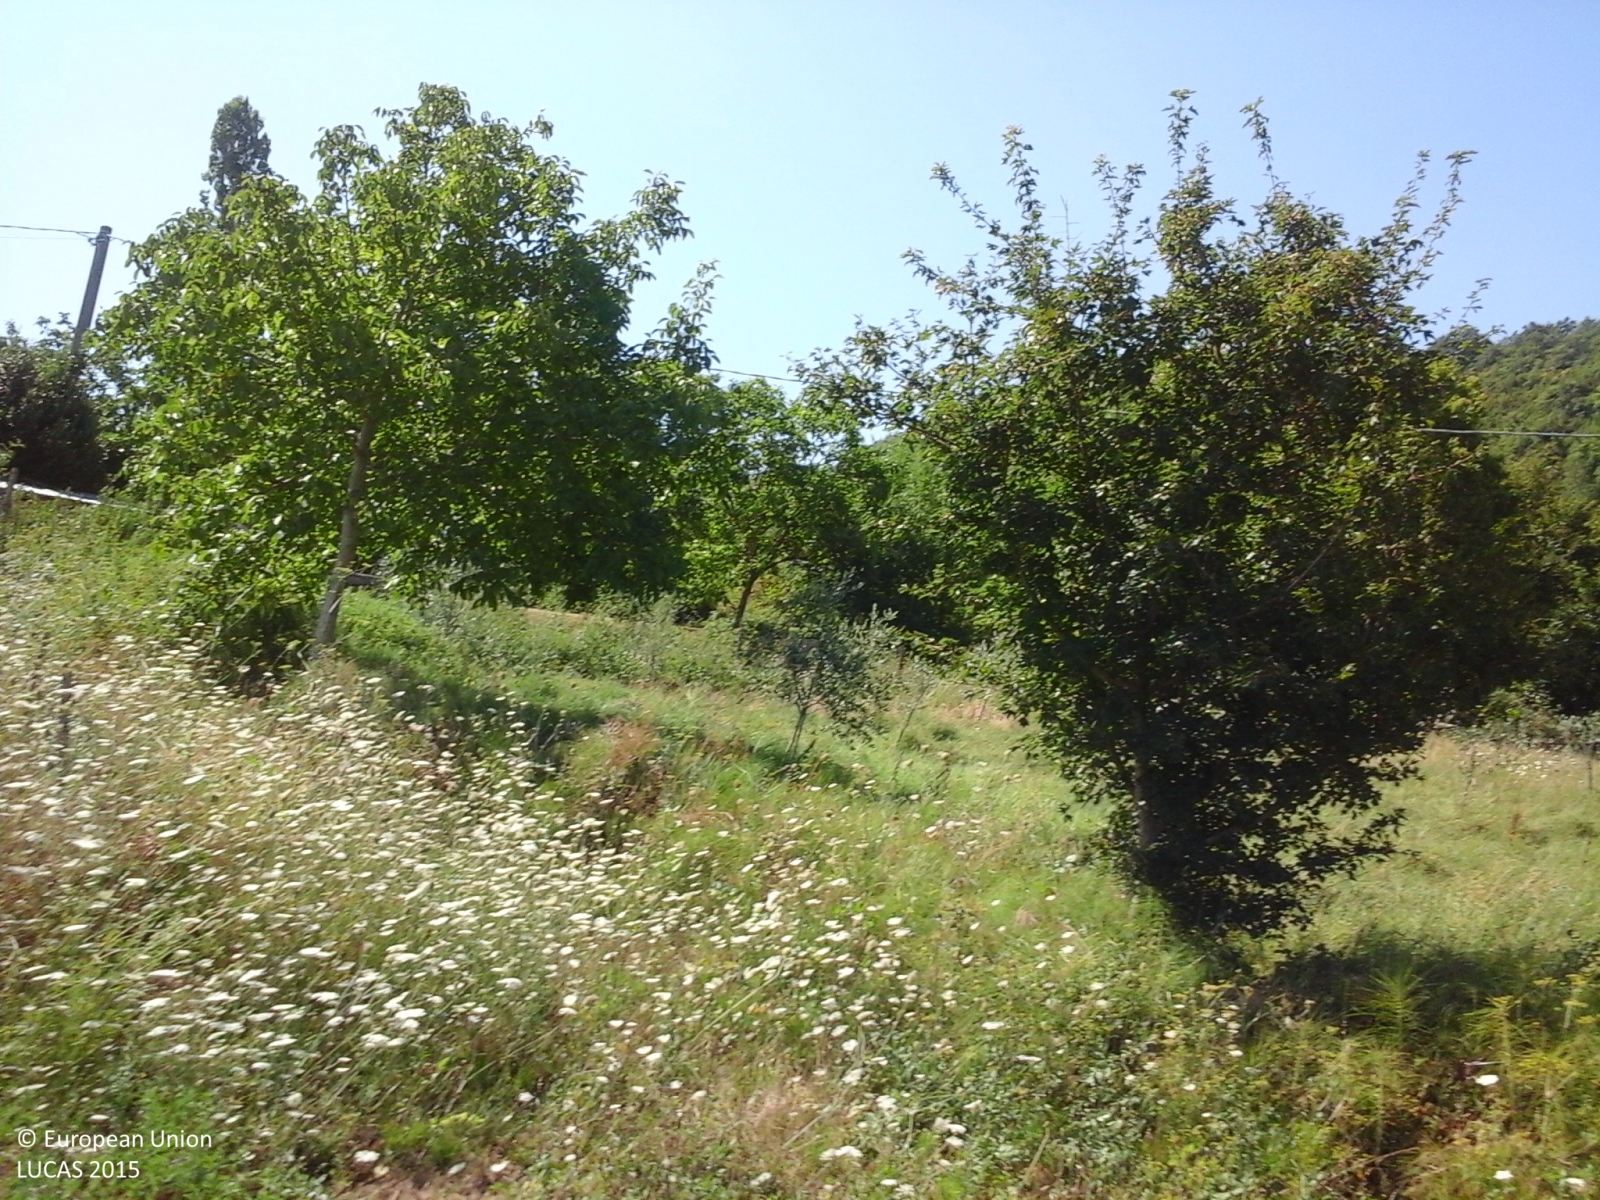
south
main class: Cropland
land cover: Lucerne
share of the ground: > 75 %
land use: Agriculture (excluding fallow land and kitchen gardens)
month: August
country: IT
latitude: 43.4608
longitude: 12.2064
